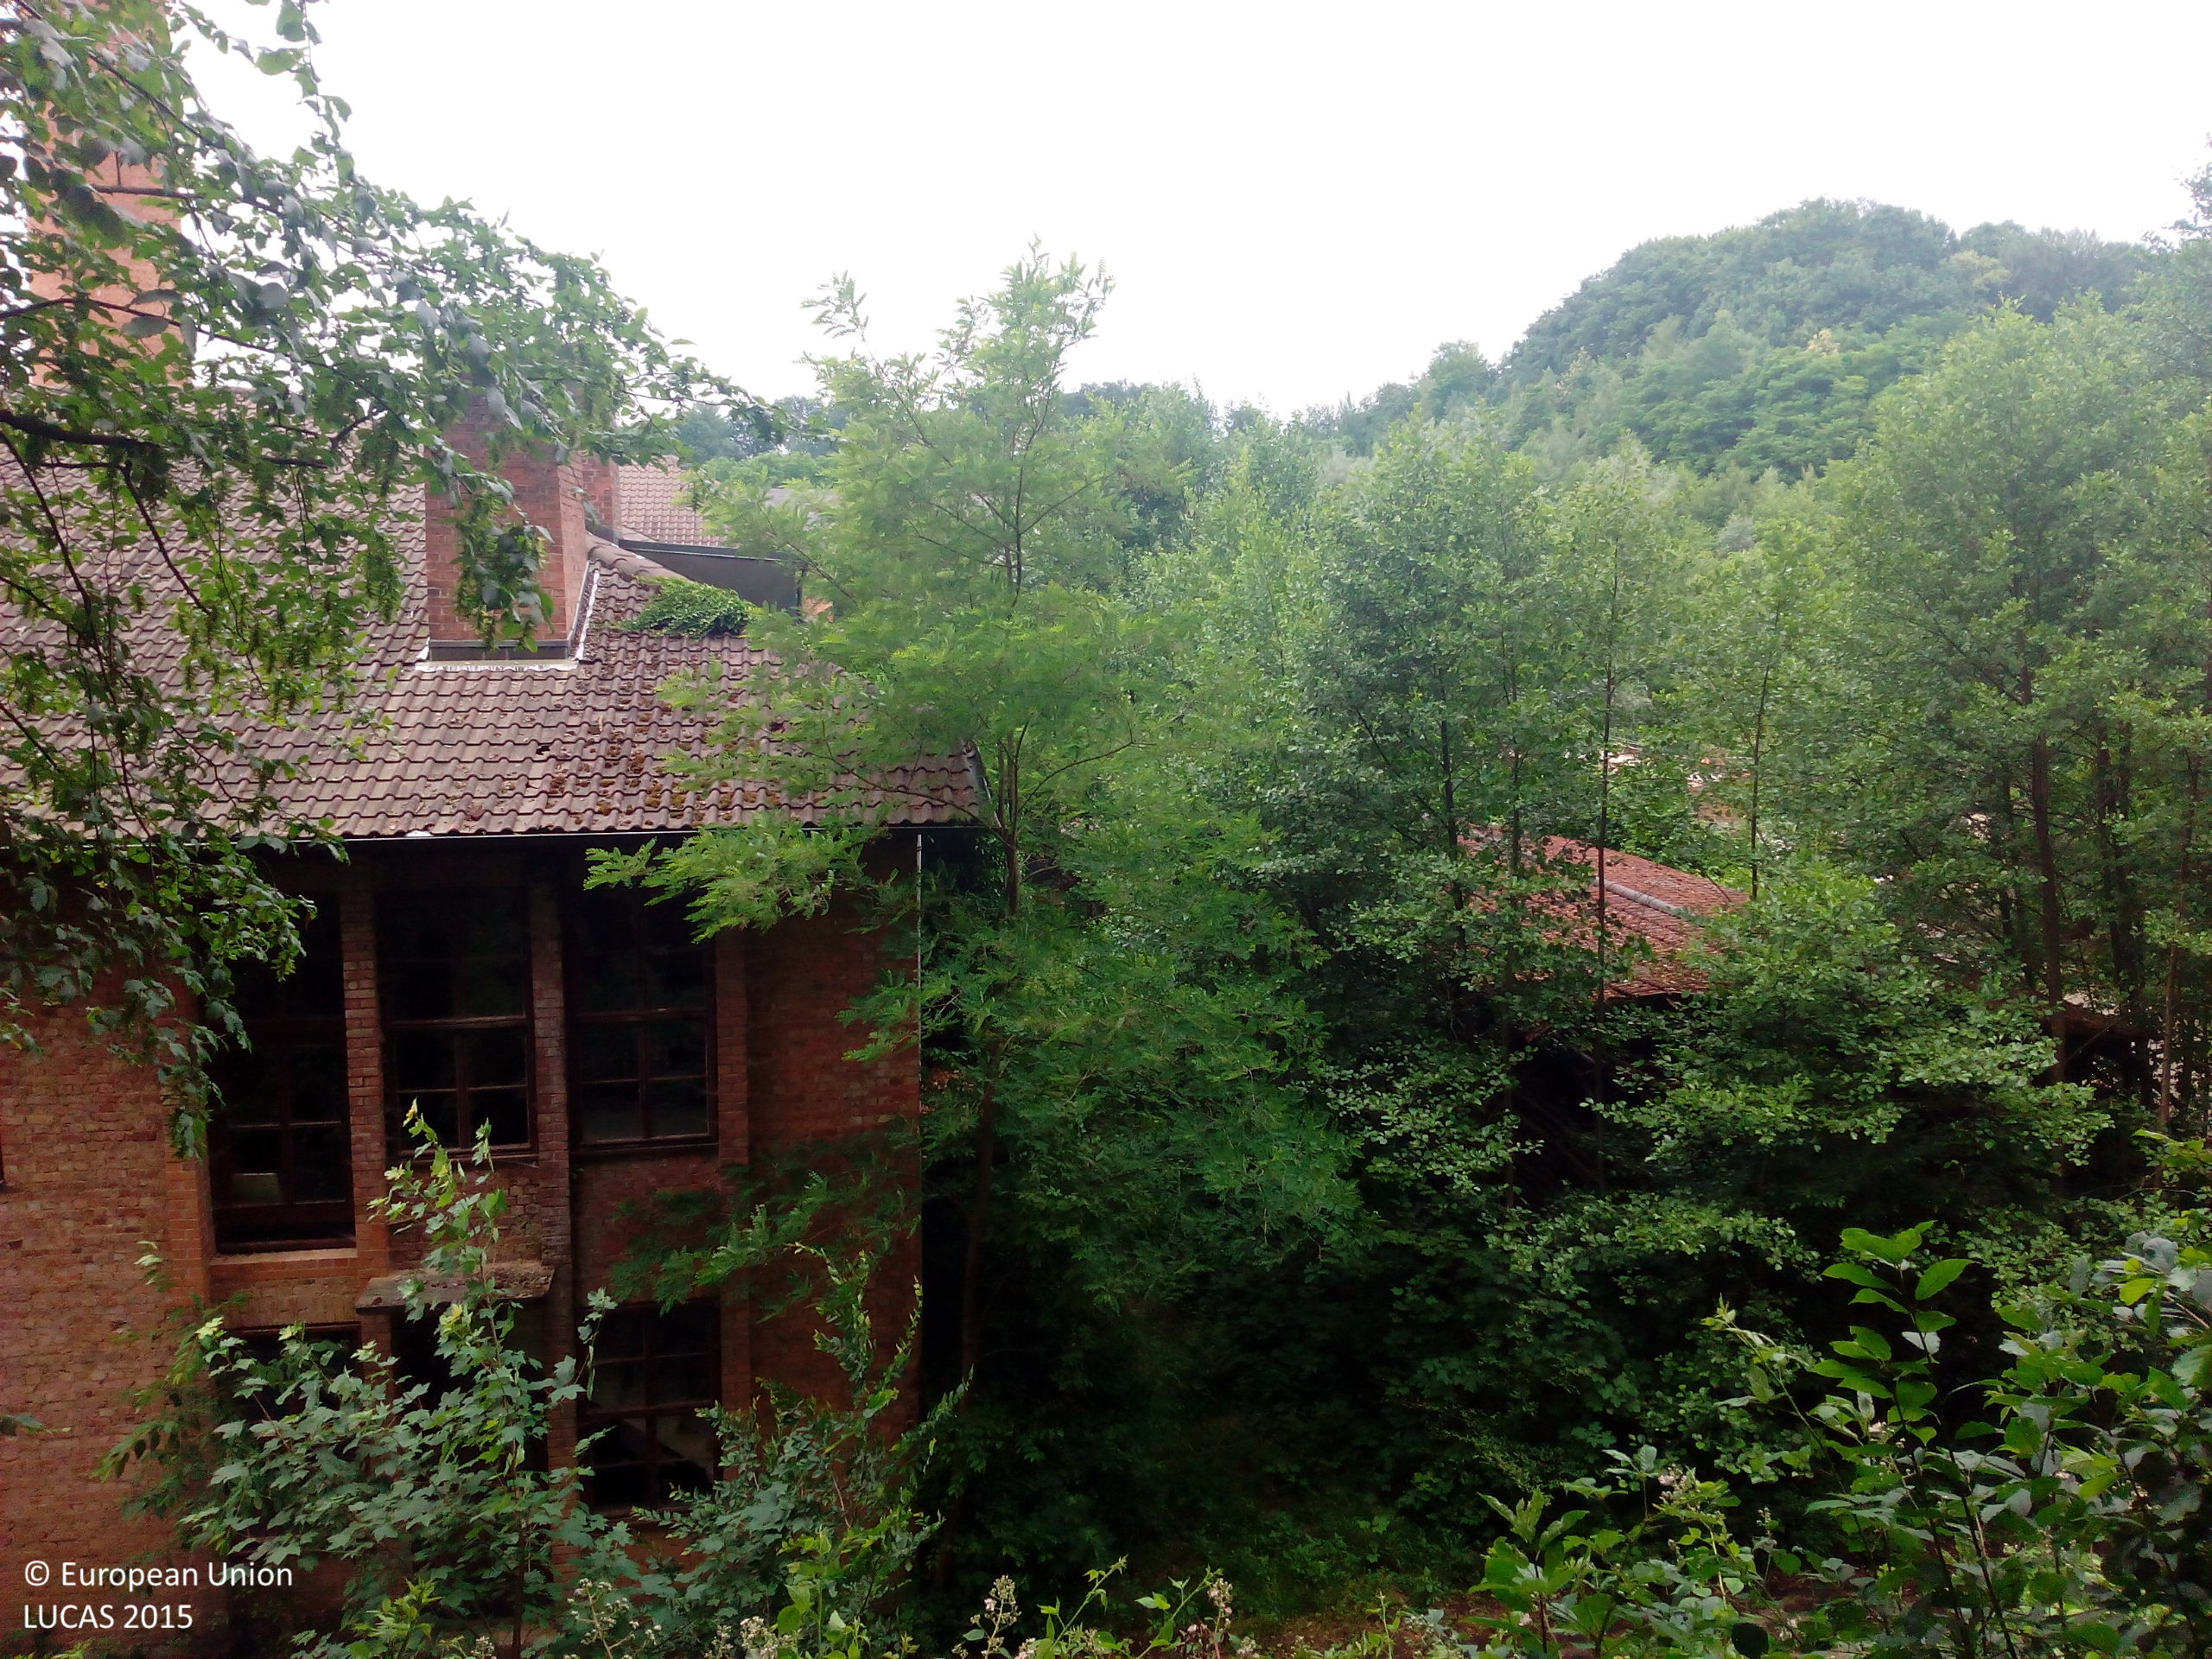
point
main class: Woodland
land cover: Broadleaved woodland
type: mesophytic deciduous forest
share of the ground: > 75 %
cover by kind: broadleaved forest trees 80 %, herbaceous plants 10 %, shrubs 5 %, consolidated bare surface 5 %
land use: Abandoned areas
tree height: > 5 m
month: June
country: DE
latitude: 48.6209
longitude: 8.0880
